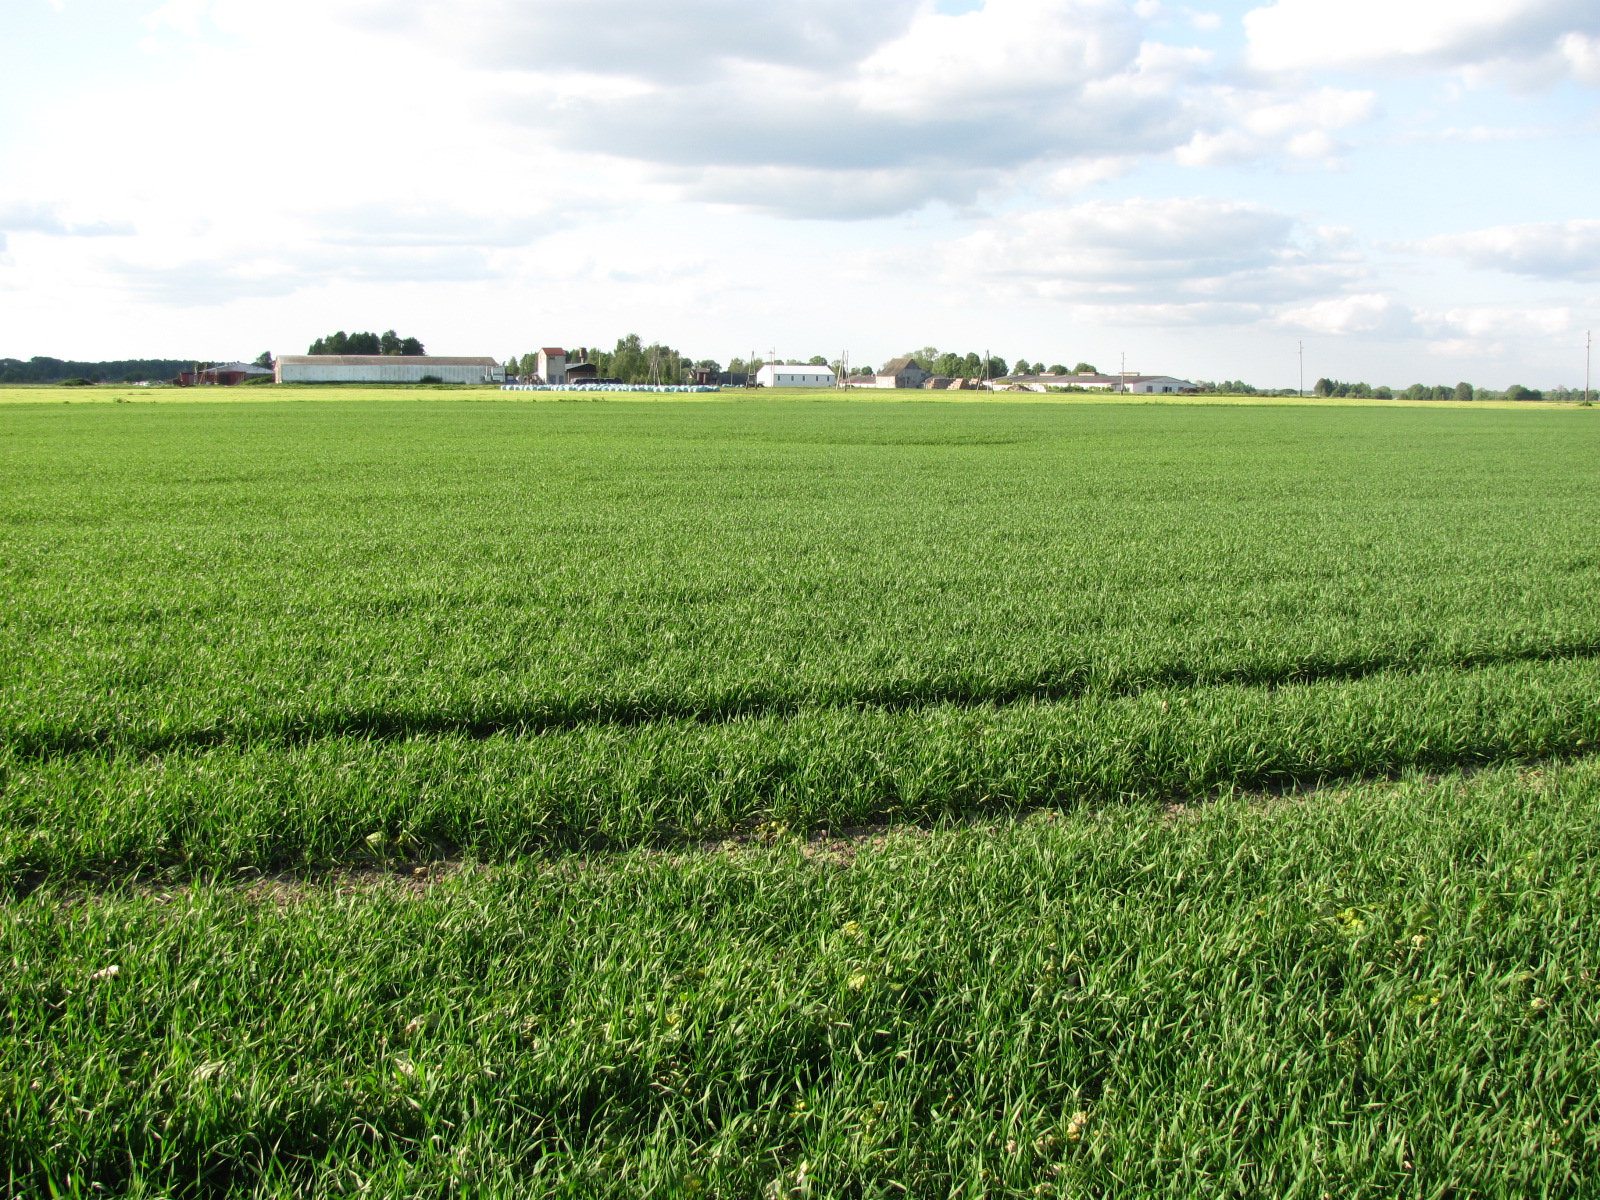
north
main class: Cropland
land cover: Common wheat
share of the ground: > 75 %
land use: Agriculture (excluding fallow land and kitchen gardens)
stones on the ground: < 10 %
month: May
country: LV
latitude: 56.5529
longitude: 23.9607
